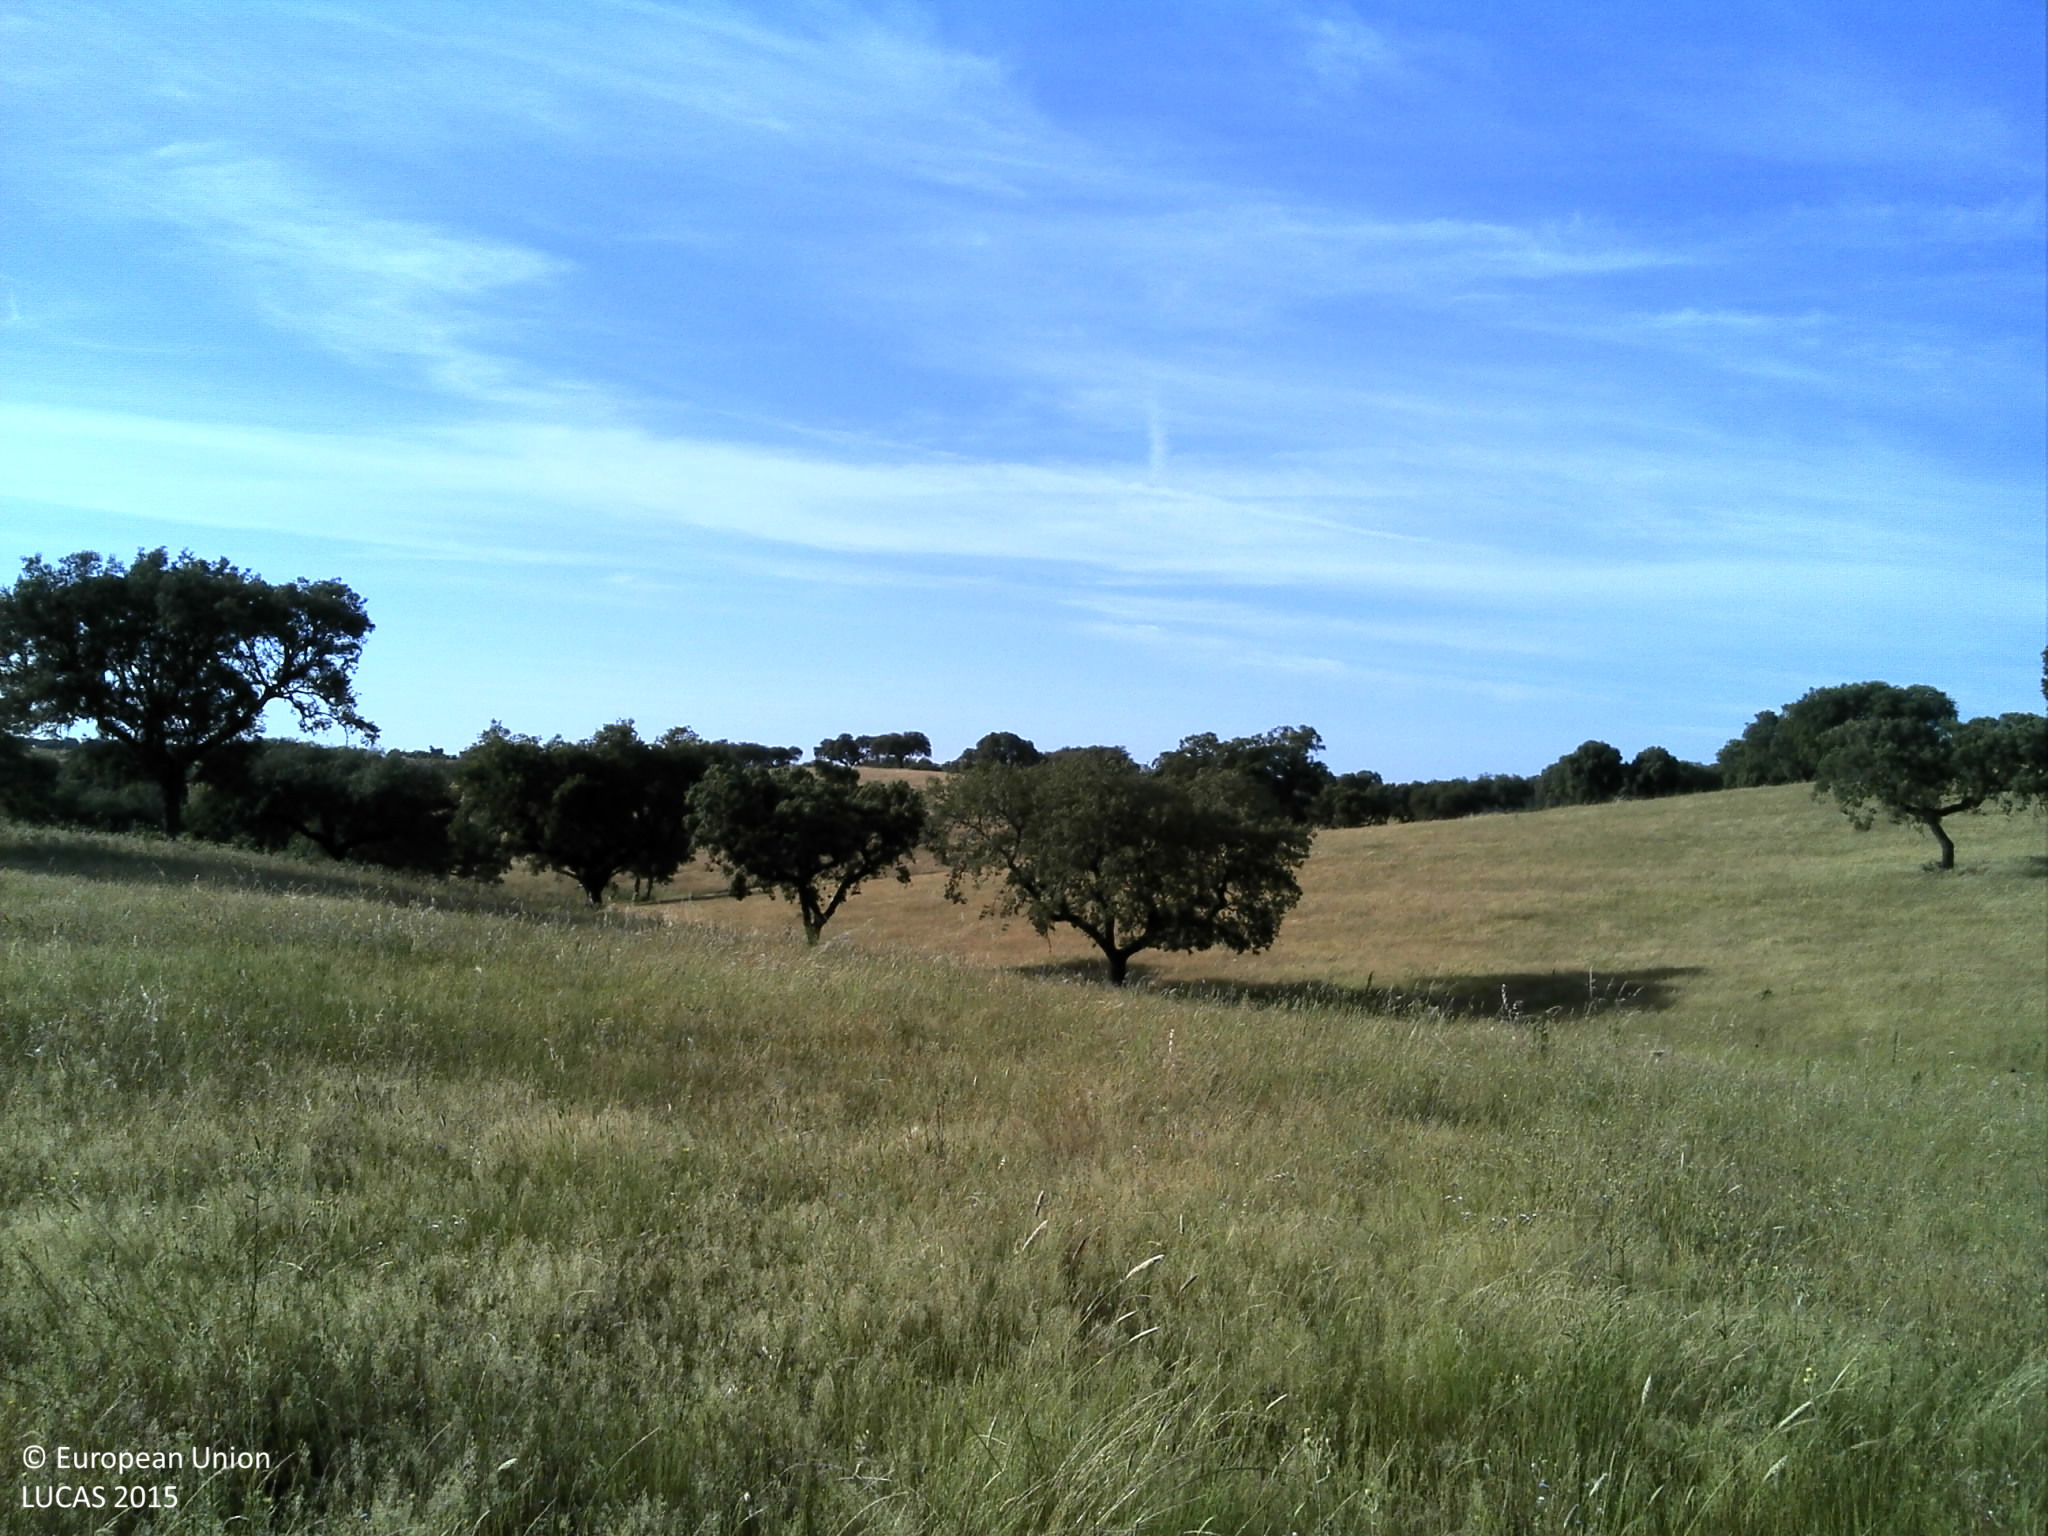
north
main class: Woodland
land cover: Broadleaved woodland
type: broadleaved evergreen forest
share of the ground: 10 - 25 %
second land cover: Grassland without tree/shrub cover
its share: 50 - 75 %
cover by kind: herbaceous plants 75 %, broadleaved forest trees 15 %, unconsolidated bare surface 10 %
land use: Forestry
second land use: Agriculture (excluding fallow land and kitchen gardens)
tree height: > 5 m
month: May
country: PT
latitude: 38.9664
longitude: -7.9484
